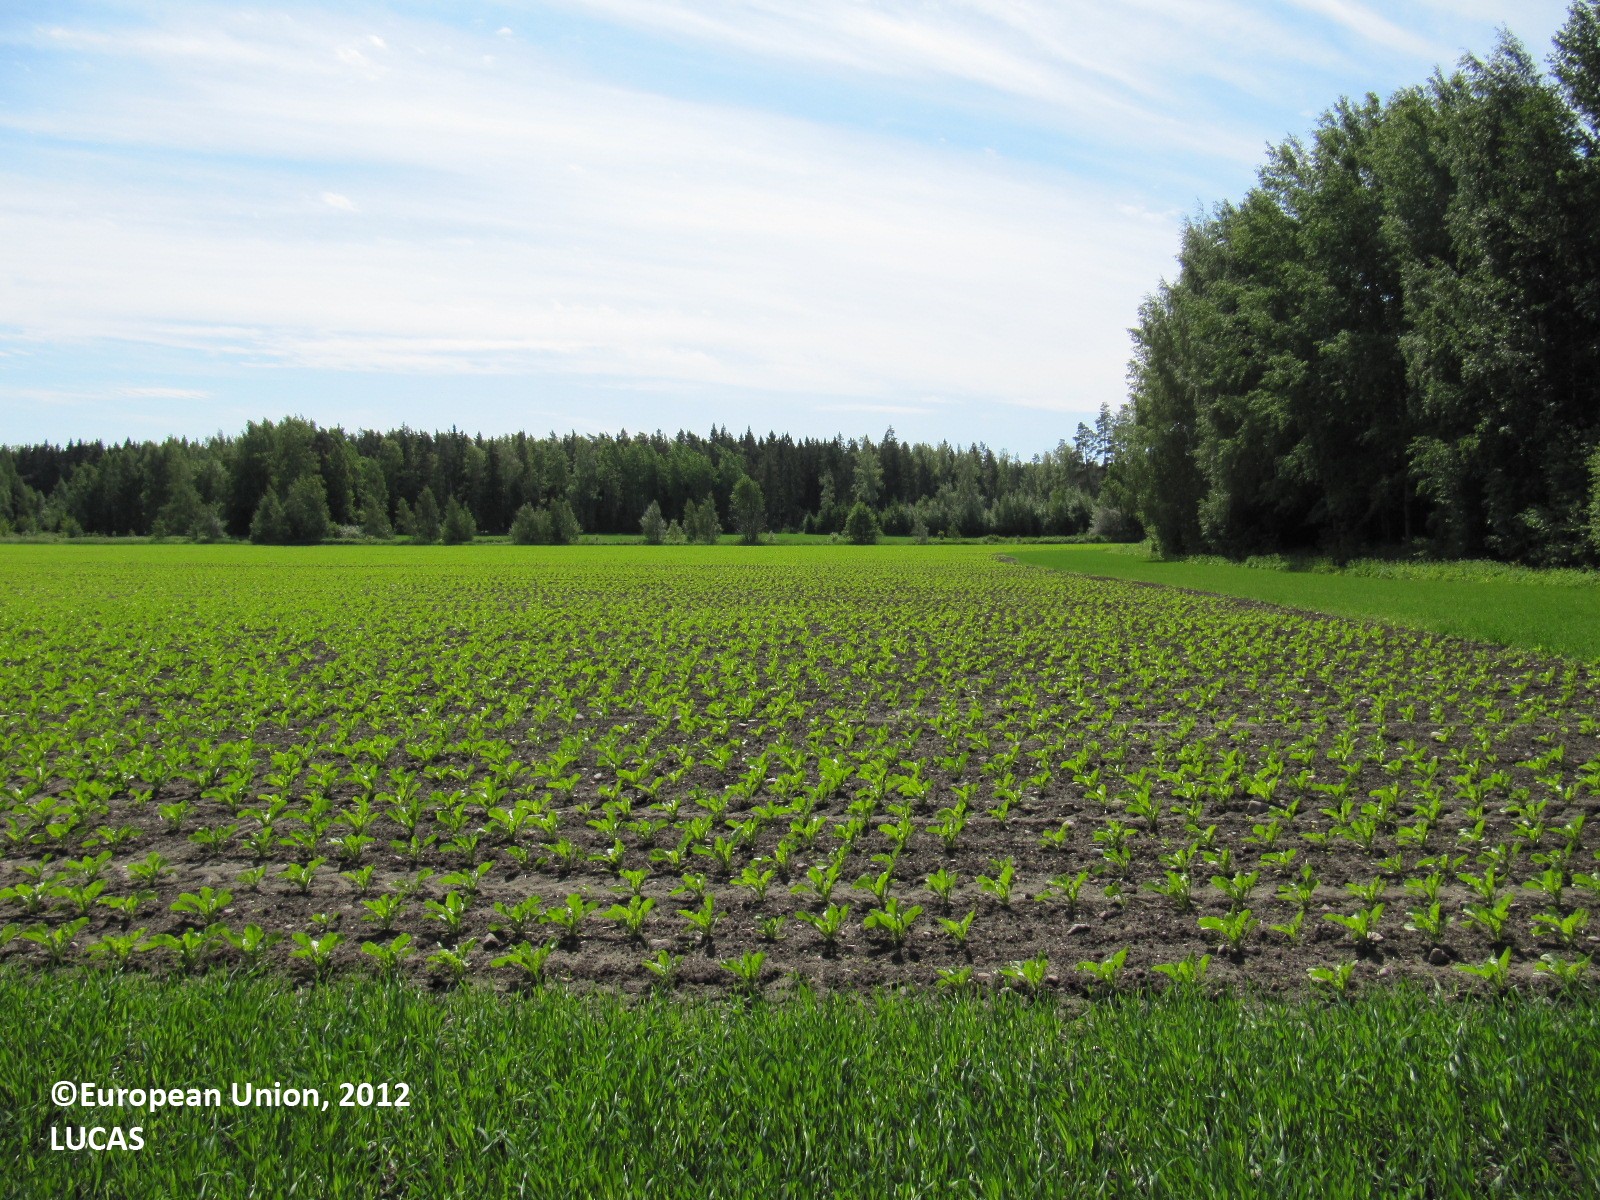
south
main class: Cropland
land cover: Sugar beet
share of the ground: 50 - 75 %
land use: Agriculture (excluding fallow land and kitchen gardens)
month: June
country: FI
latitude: 59.9667
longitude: 22.9233
